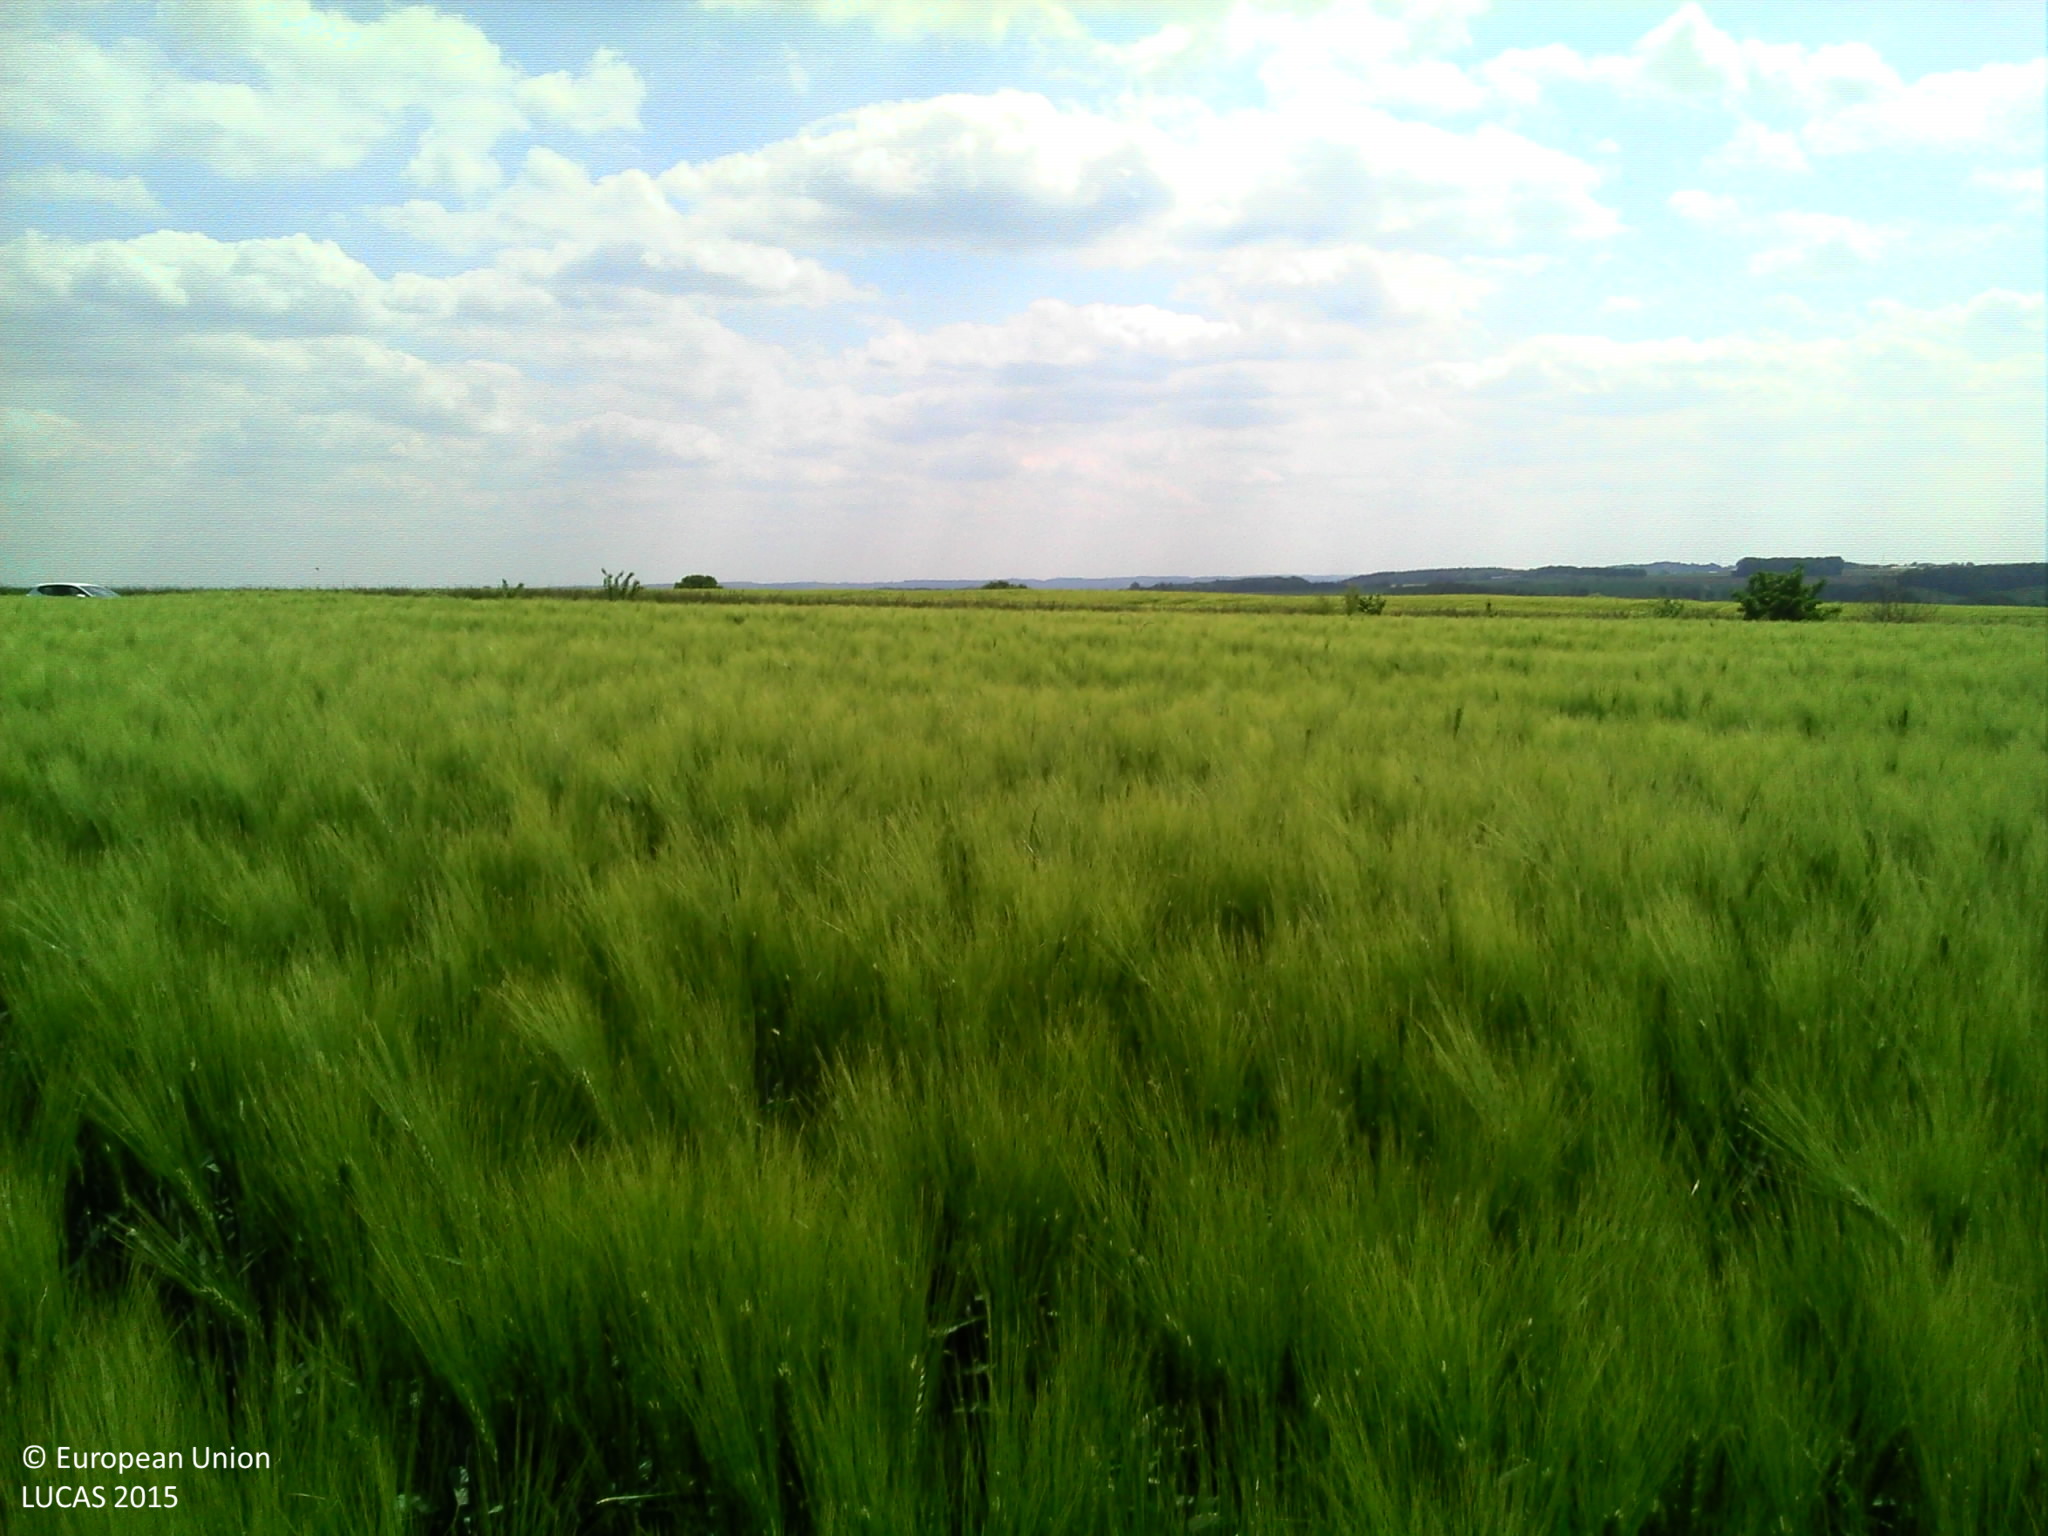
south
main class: Cropland
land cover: Barley
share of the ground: > 75 %
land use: Agriculture (excluding fallow land and kitchen gardens)
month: May
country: BE
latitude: 50.6227
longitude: 5.1775
